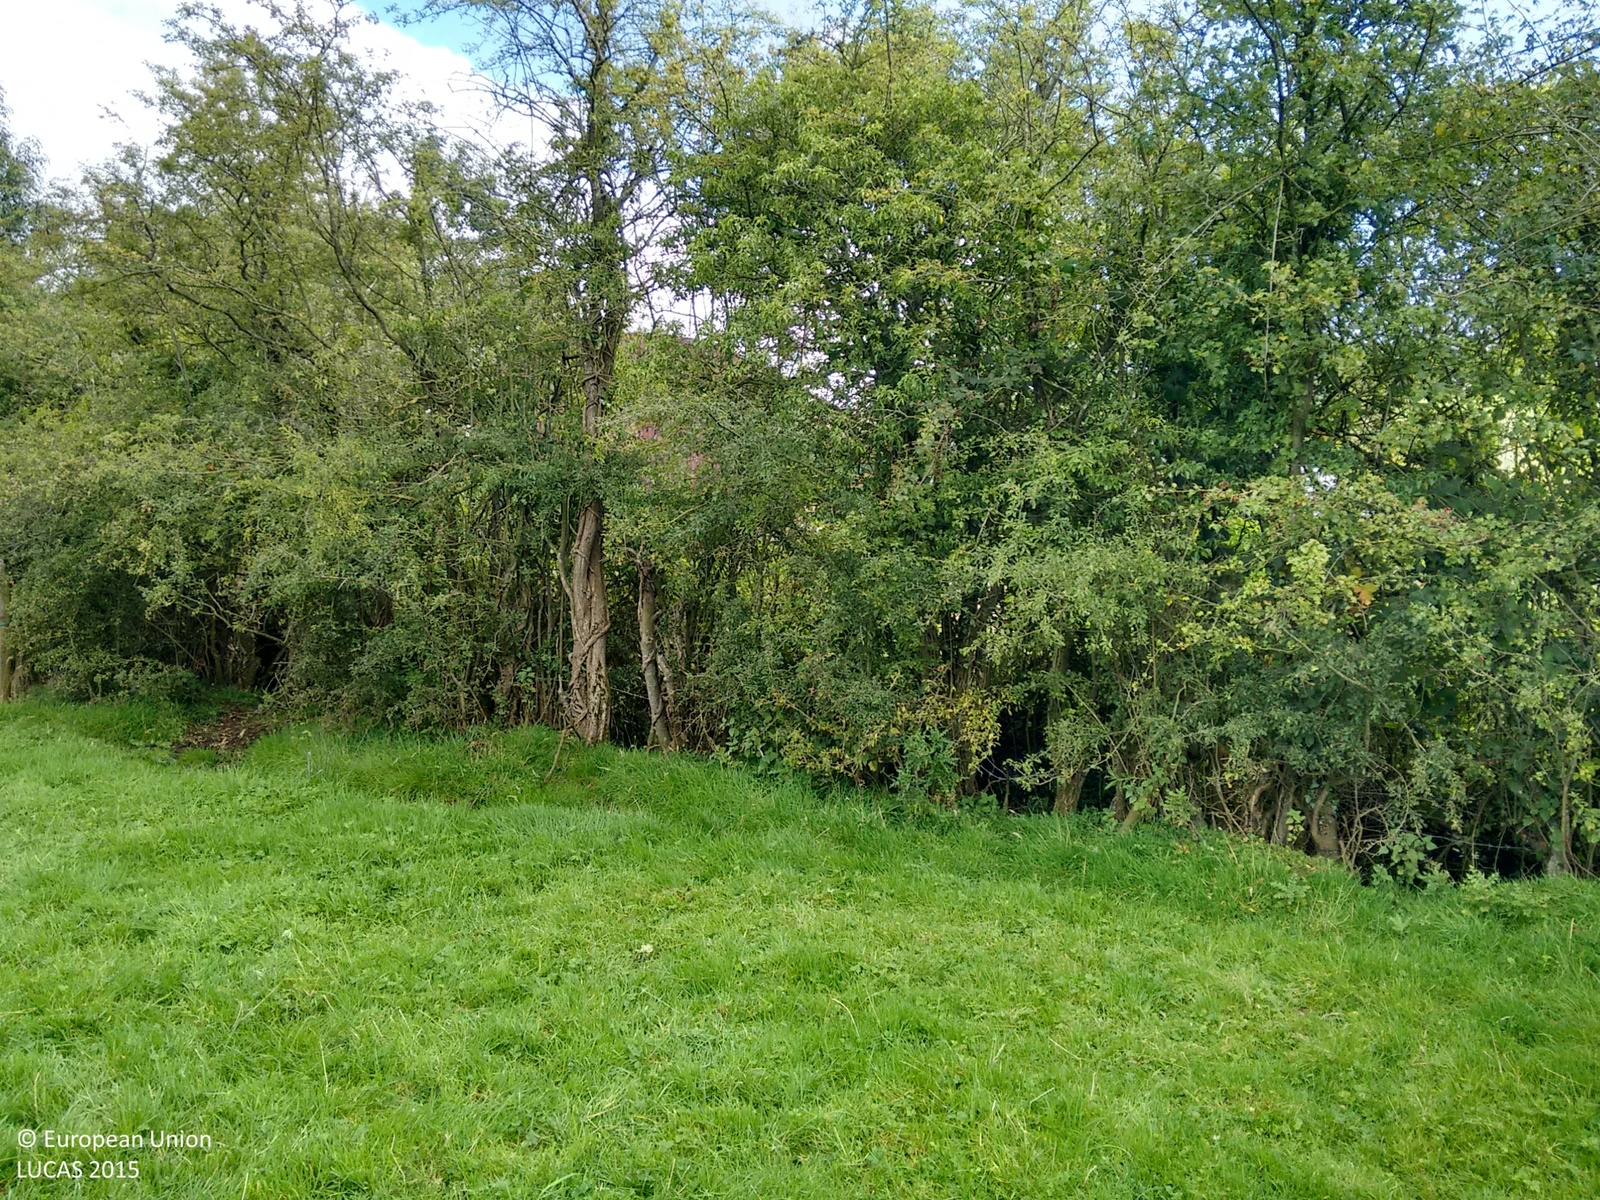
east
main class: Grassland
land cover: Grassland without tree/shrub cover
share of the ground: > 75 %
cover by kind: herbaceous plants 95 %, shrubs 5 %
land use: Agriculture (excluding fallow land and kitchen gardens)
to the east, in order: Grassland without tree/shrub cover; Managed hedges; Artificial constructions in urban areas; Grassland without tree/shrub cover; Fences; Grassland without tree/shrub cover
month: September
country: IE
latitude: 54.2774
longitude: -6.9241
